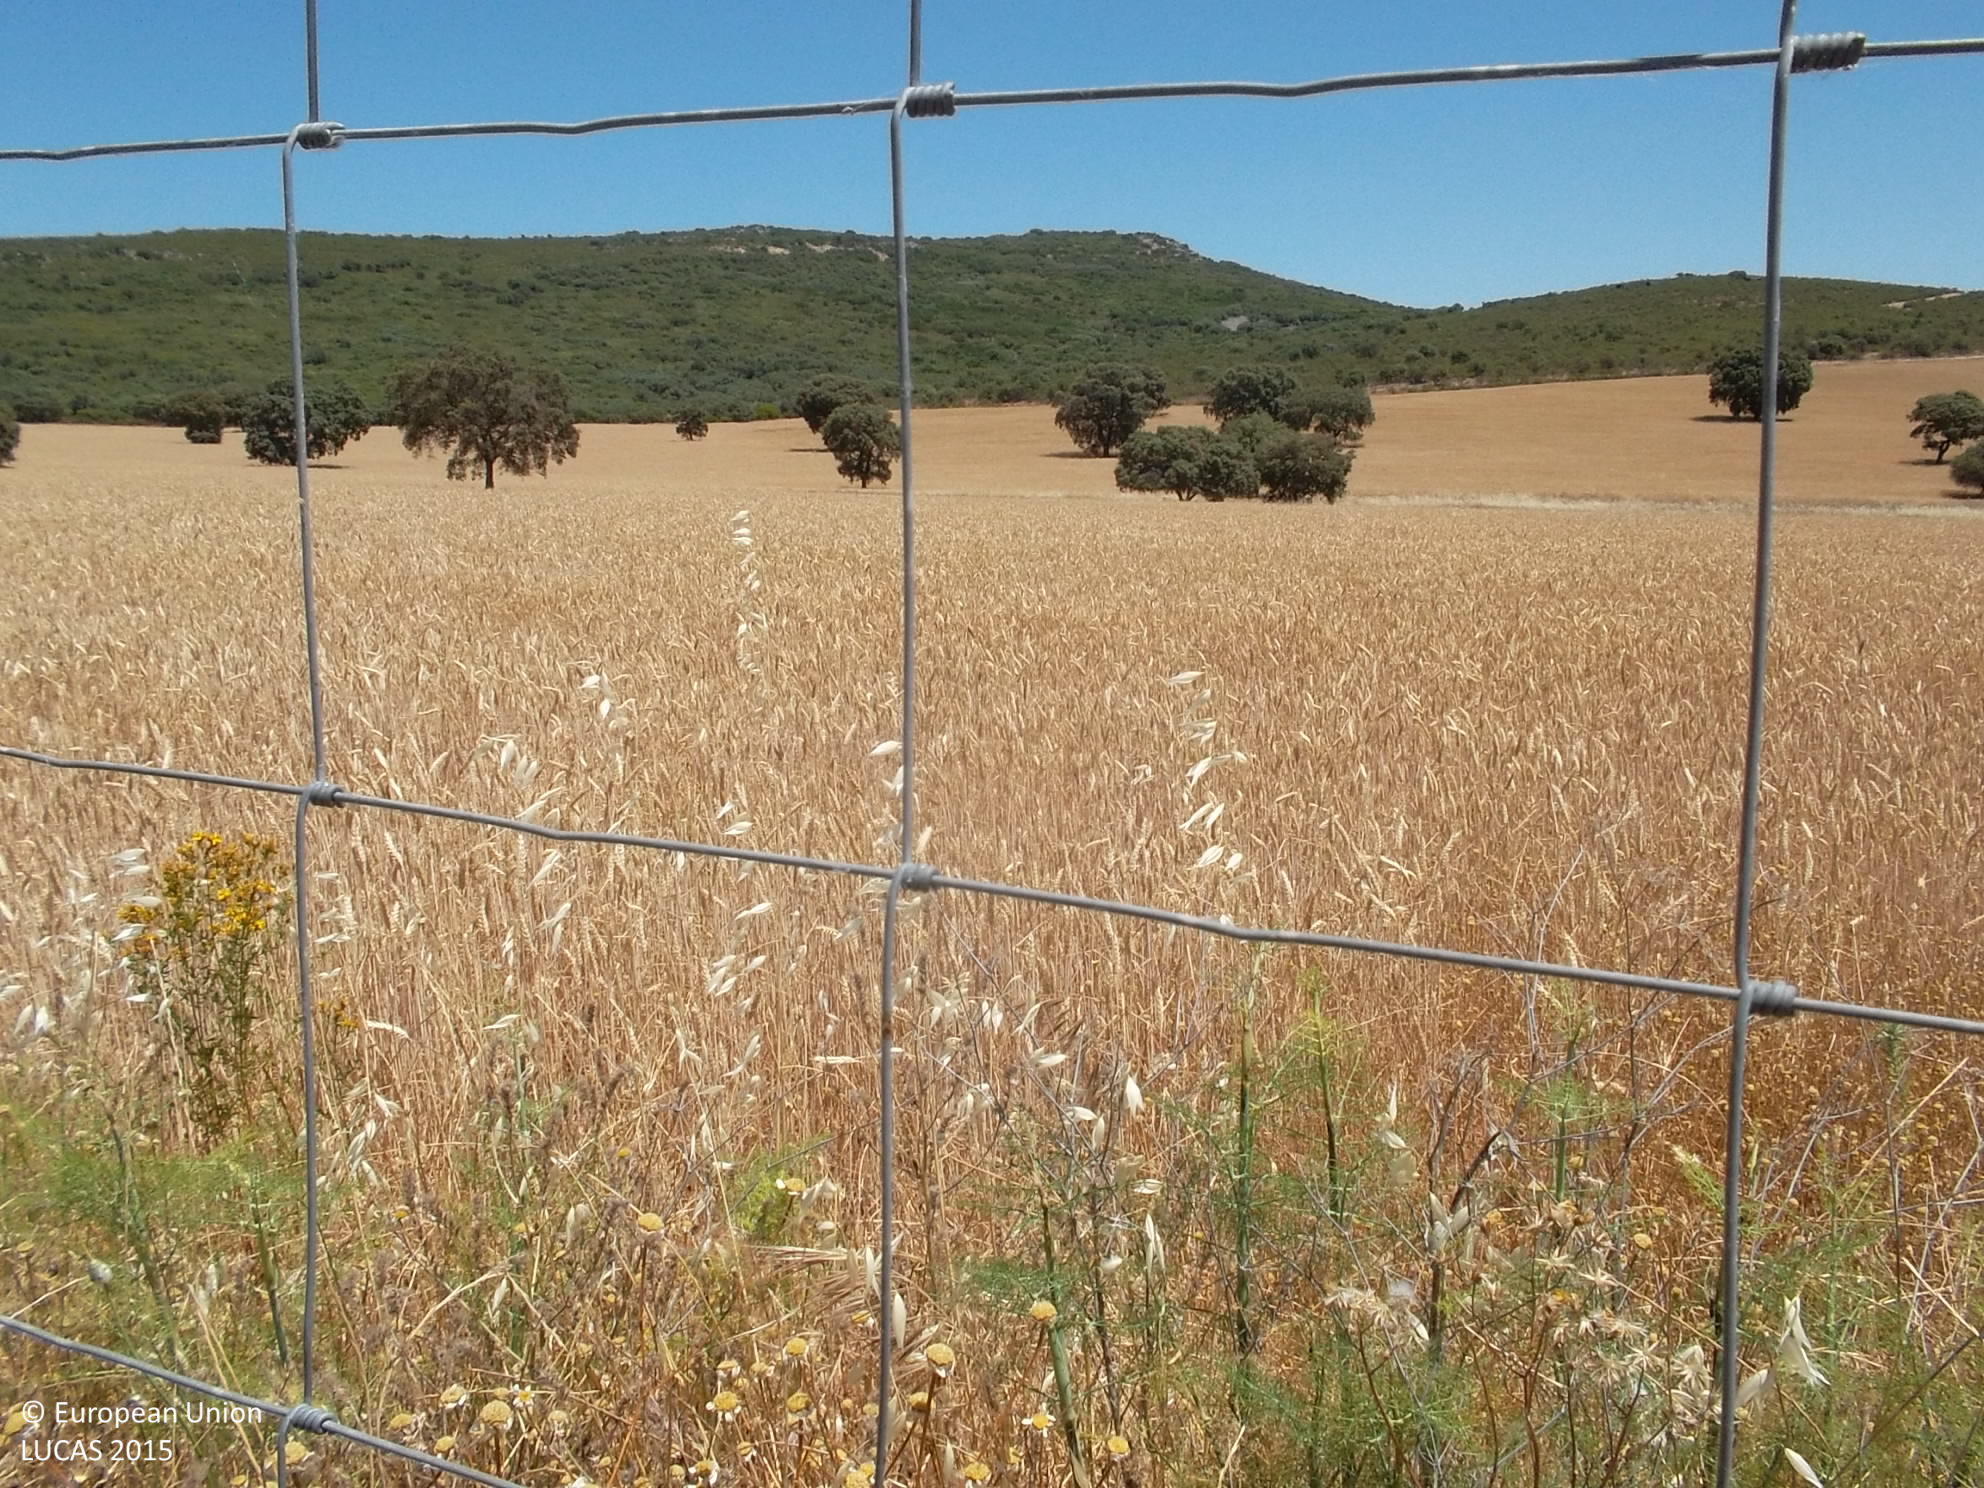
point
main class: Cropland
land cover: Common wheat
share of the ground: > 75 %
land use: Agriculture (excluding fallow land and kitchen gardens)
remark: Harvested field
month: June
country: ES
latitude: 39.0973
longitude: -4.0959
